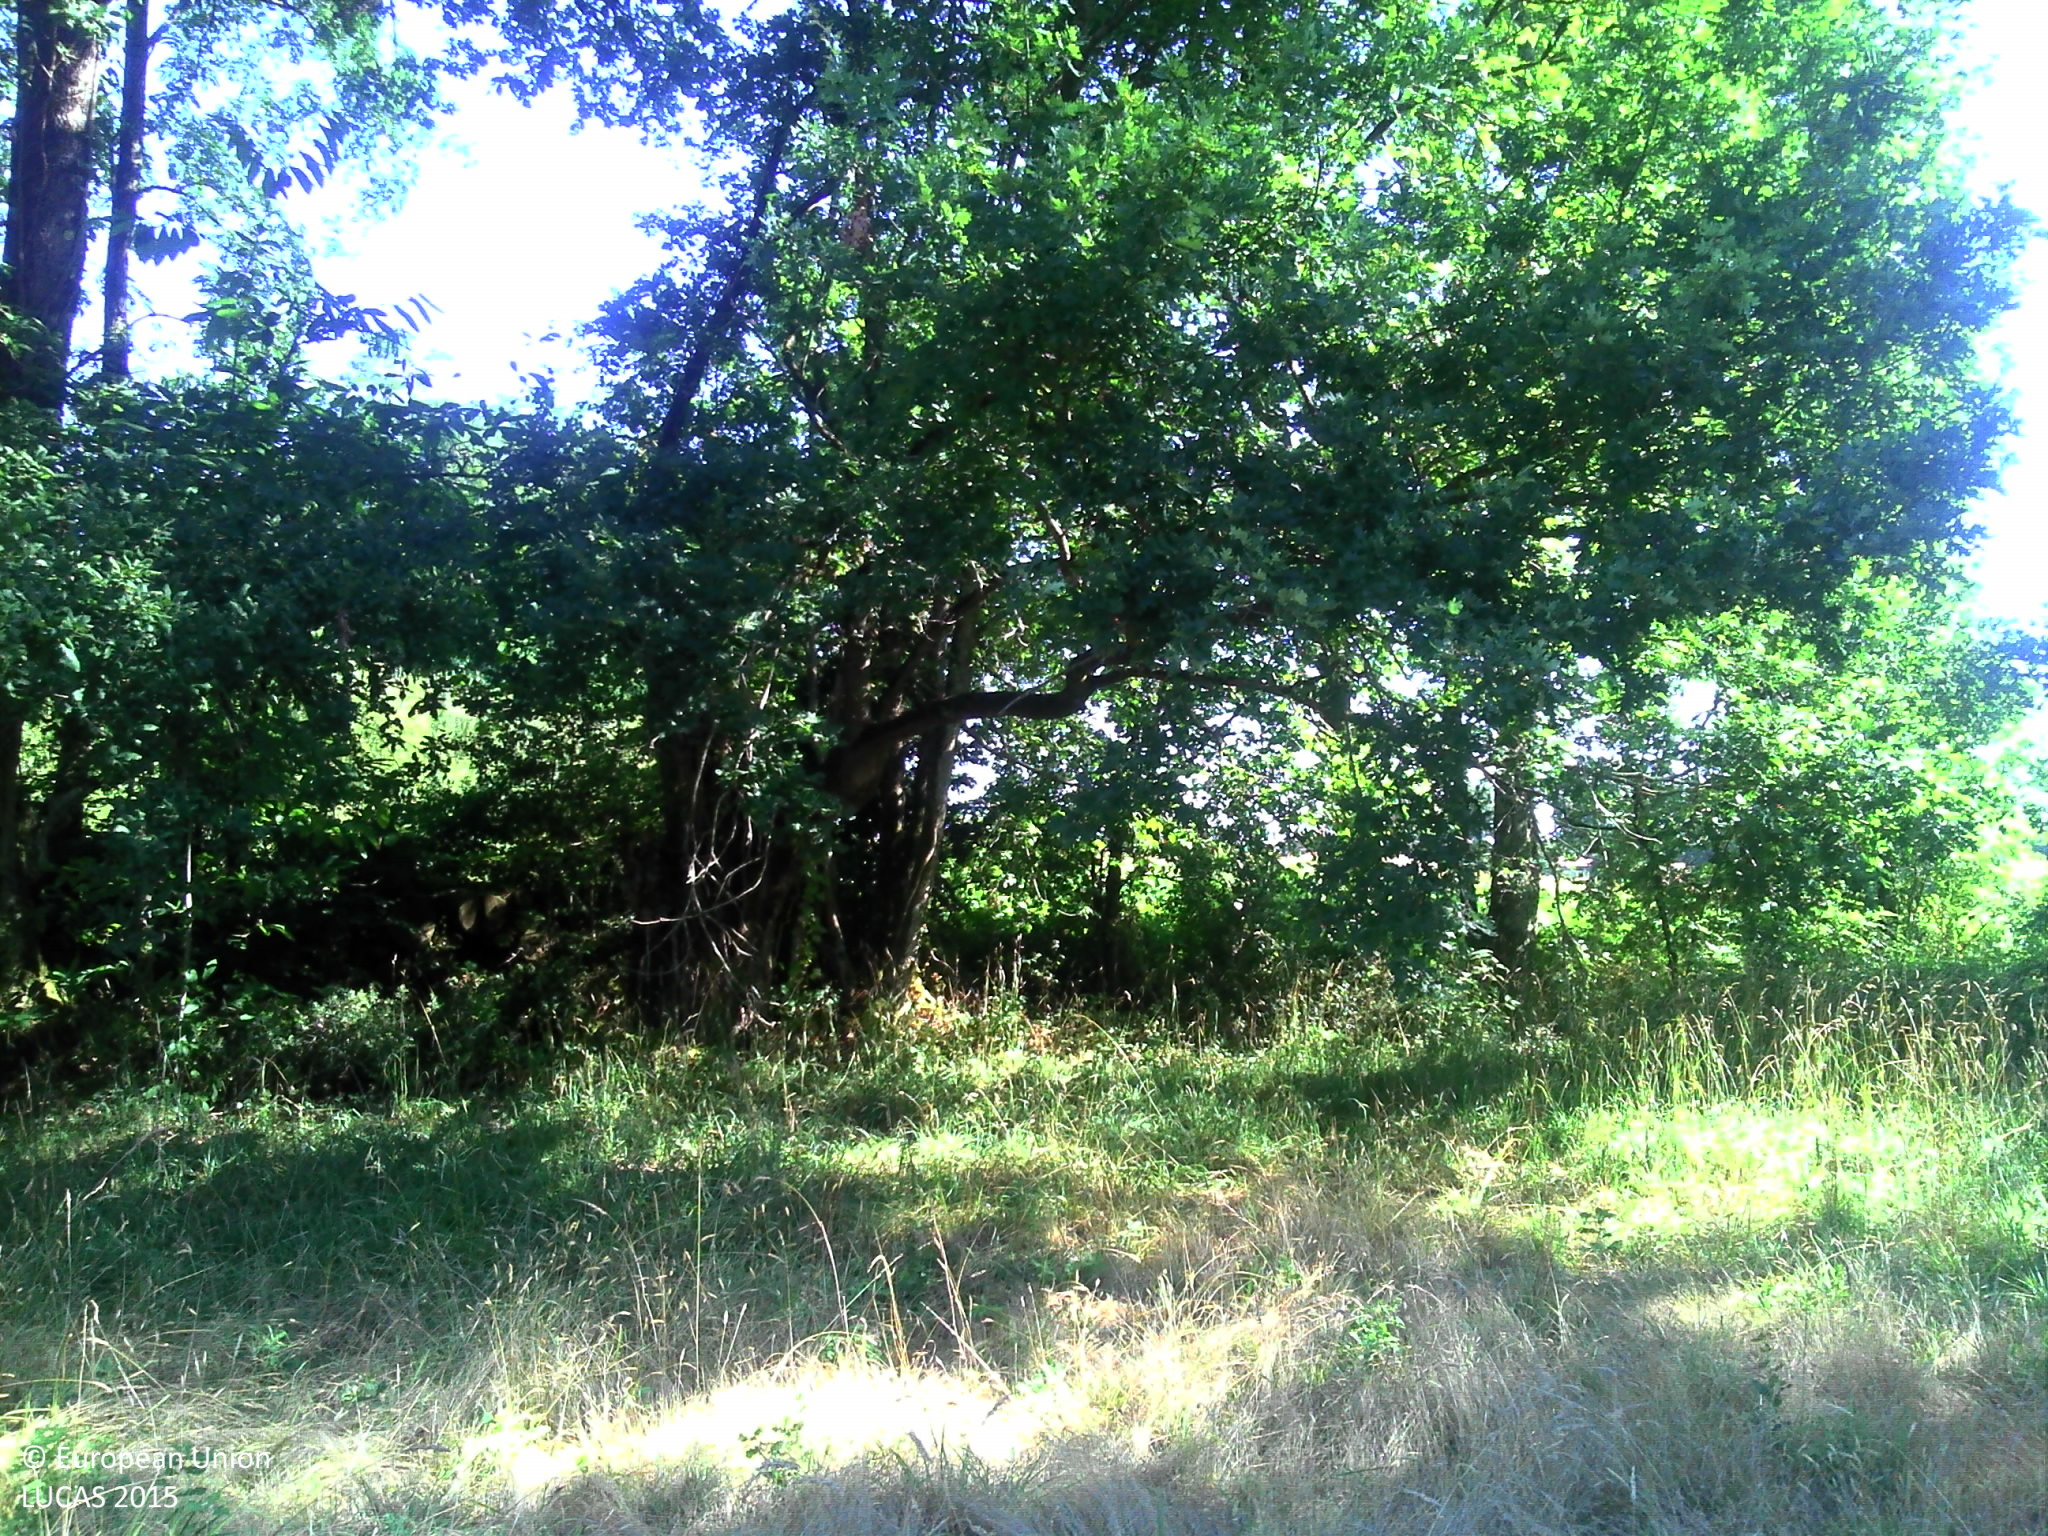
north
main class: Grassland
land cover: Grassland without tree/shrub cover
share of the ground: > 75 %
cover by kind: herbaceous plants 95 %, shrubs 5 %
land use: Agriculture (excluding fallow land and kitchen gardens)
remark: Temporary dry
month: July
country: FR
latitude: 43.6428
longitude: -1.1108
